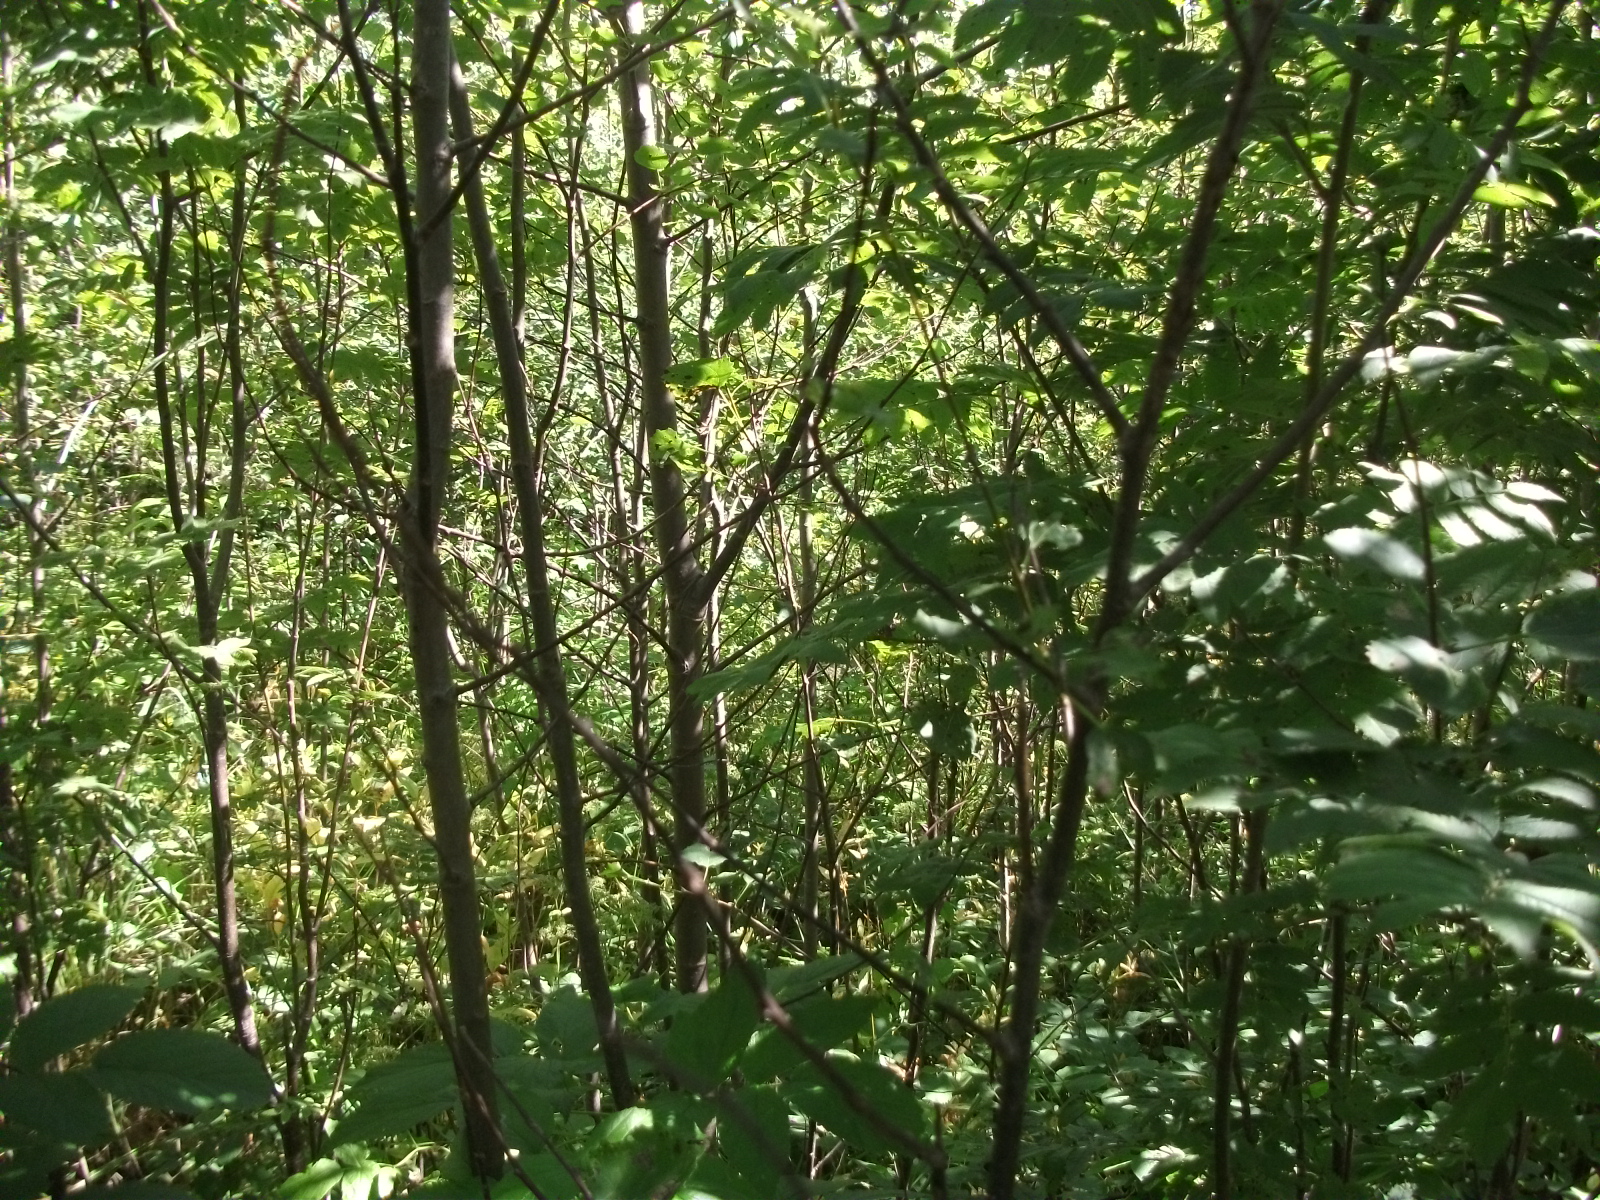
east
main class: Woodland
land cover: Broadleaved woodland
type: non-riverine alder, birch or aspen forest
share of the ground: > 75 %
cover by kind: broadleaved forest trees 95 %, shrubs 5 %
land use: Forestry
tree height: < 5 m
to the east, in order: Broadleaved woodland; Ditches and canals; Common wheat; Shruby margins; Ditches and canals; Shruby margins; Common wheat
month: August
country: LV
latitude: 56.9917
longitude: 26.4550
